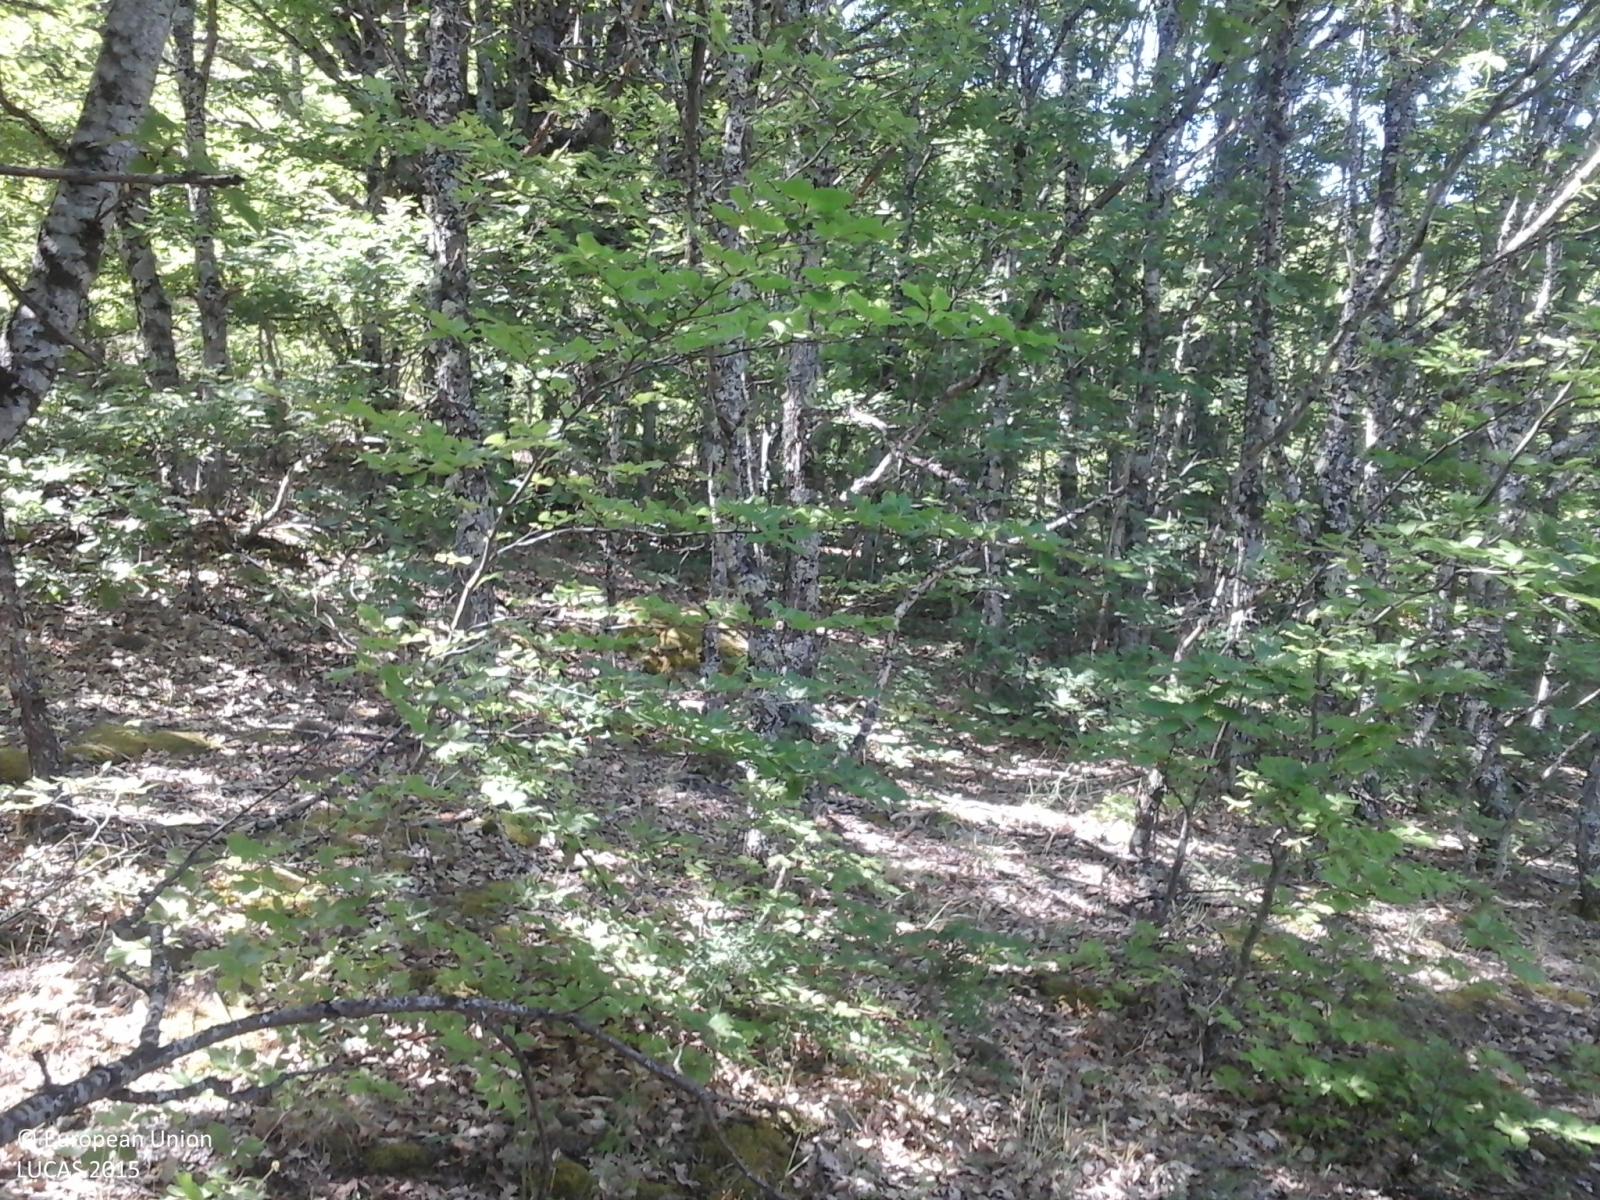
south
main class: Woodland
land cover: Broadleaved woodland
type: thermophilous deciduous forest
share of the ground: > 75 %
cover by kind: broadleaved forest trees 75 %, herbaceous plants 20 %, lichens and mosses 5 %
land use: Forestry
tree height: > 5 m
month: June
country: GR
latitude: 40.6129
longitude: 21.3264
